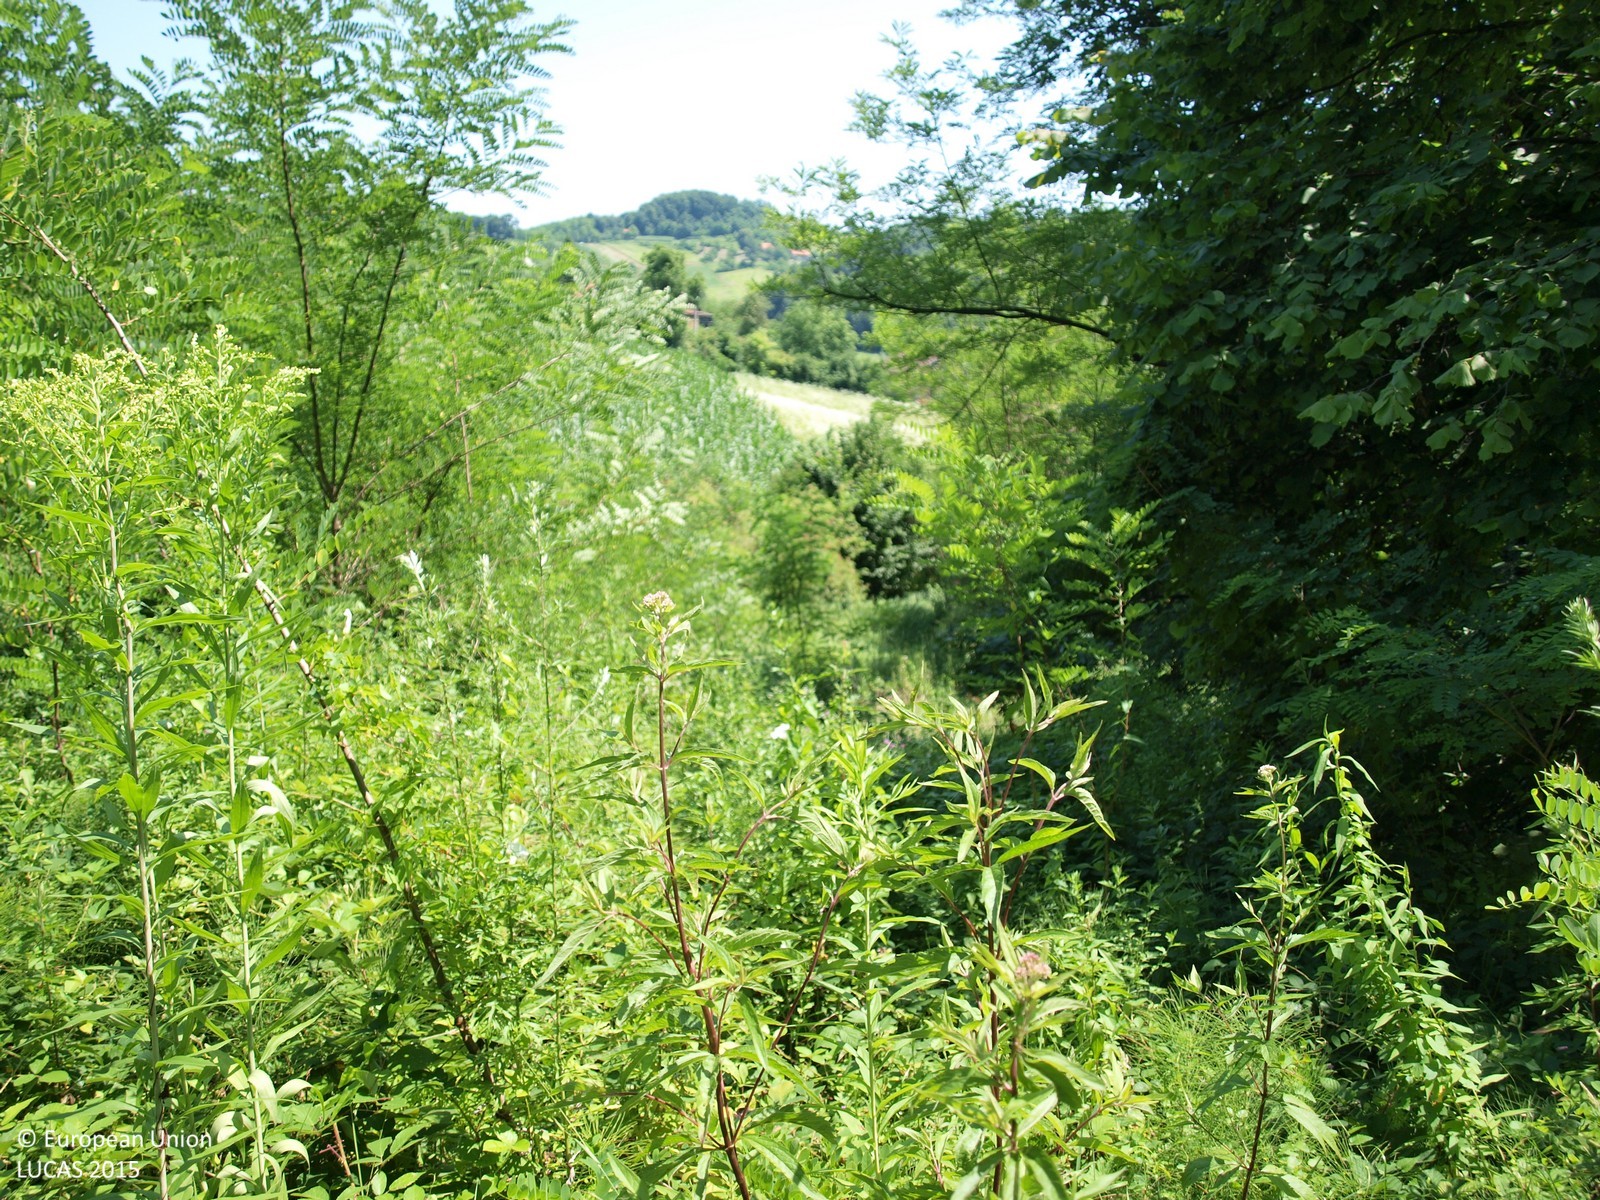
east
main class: Shrubland
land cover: Shrubland with sparse tree cover
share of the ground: > 75 %
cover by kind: shrubs 85 %, herbaceous plants 10 %, broadleaved forest trees 5 %
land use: Semi-natural and natural areas not in use
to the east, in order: Shrubland with sparse tree cover; Maize; Grassland without tree/shrub cover; Artificial constructions in urban areas
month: July
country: HR
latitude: 46.0781
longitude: 15.9337
